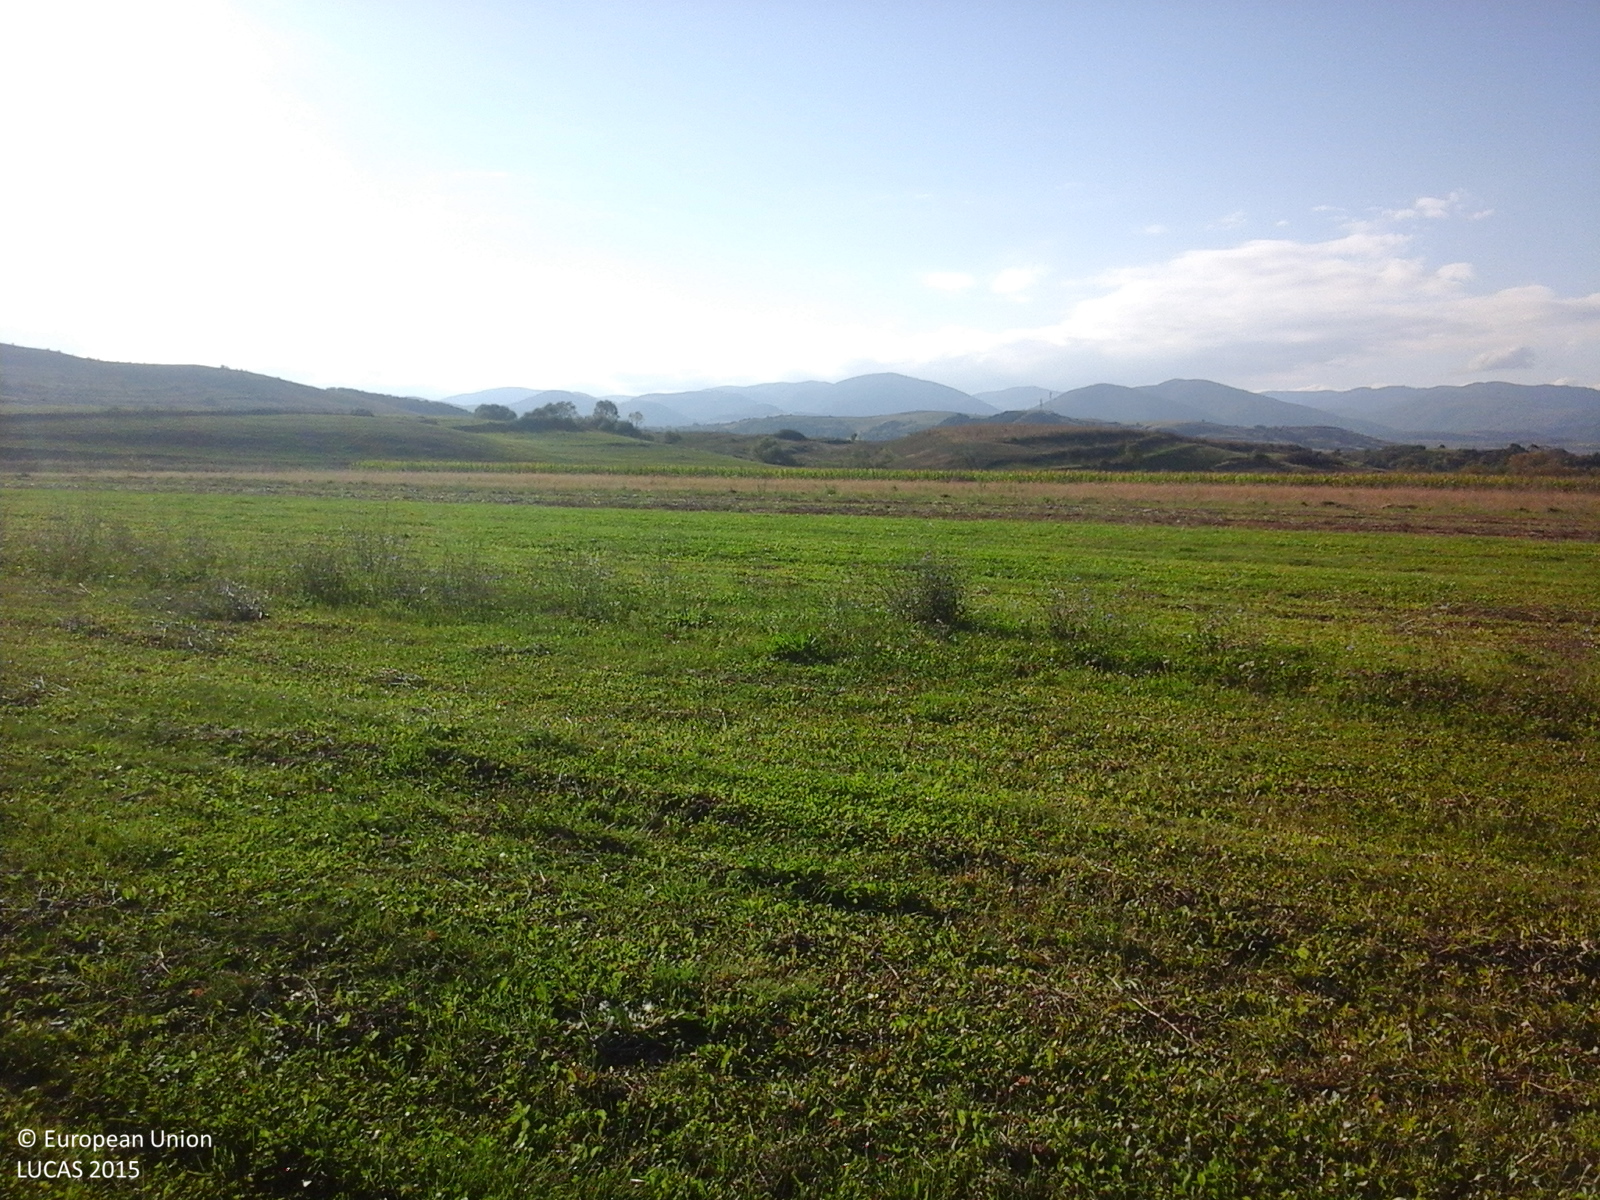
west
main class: Grassland
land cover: Grassland without tree/shrub cover
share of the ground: > 75 %
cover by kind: herbaceous plants 100 %
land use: Agriculture (excluding fallow land and kitchen gardens)
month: October
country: RO
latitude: 46.5474
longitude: 23.5141
